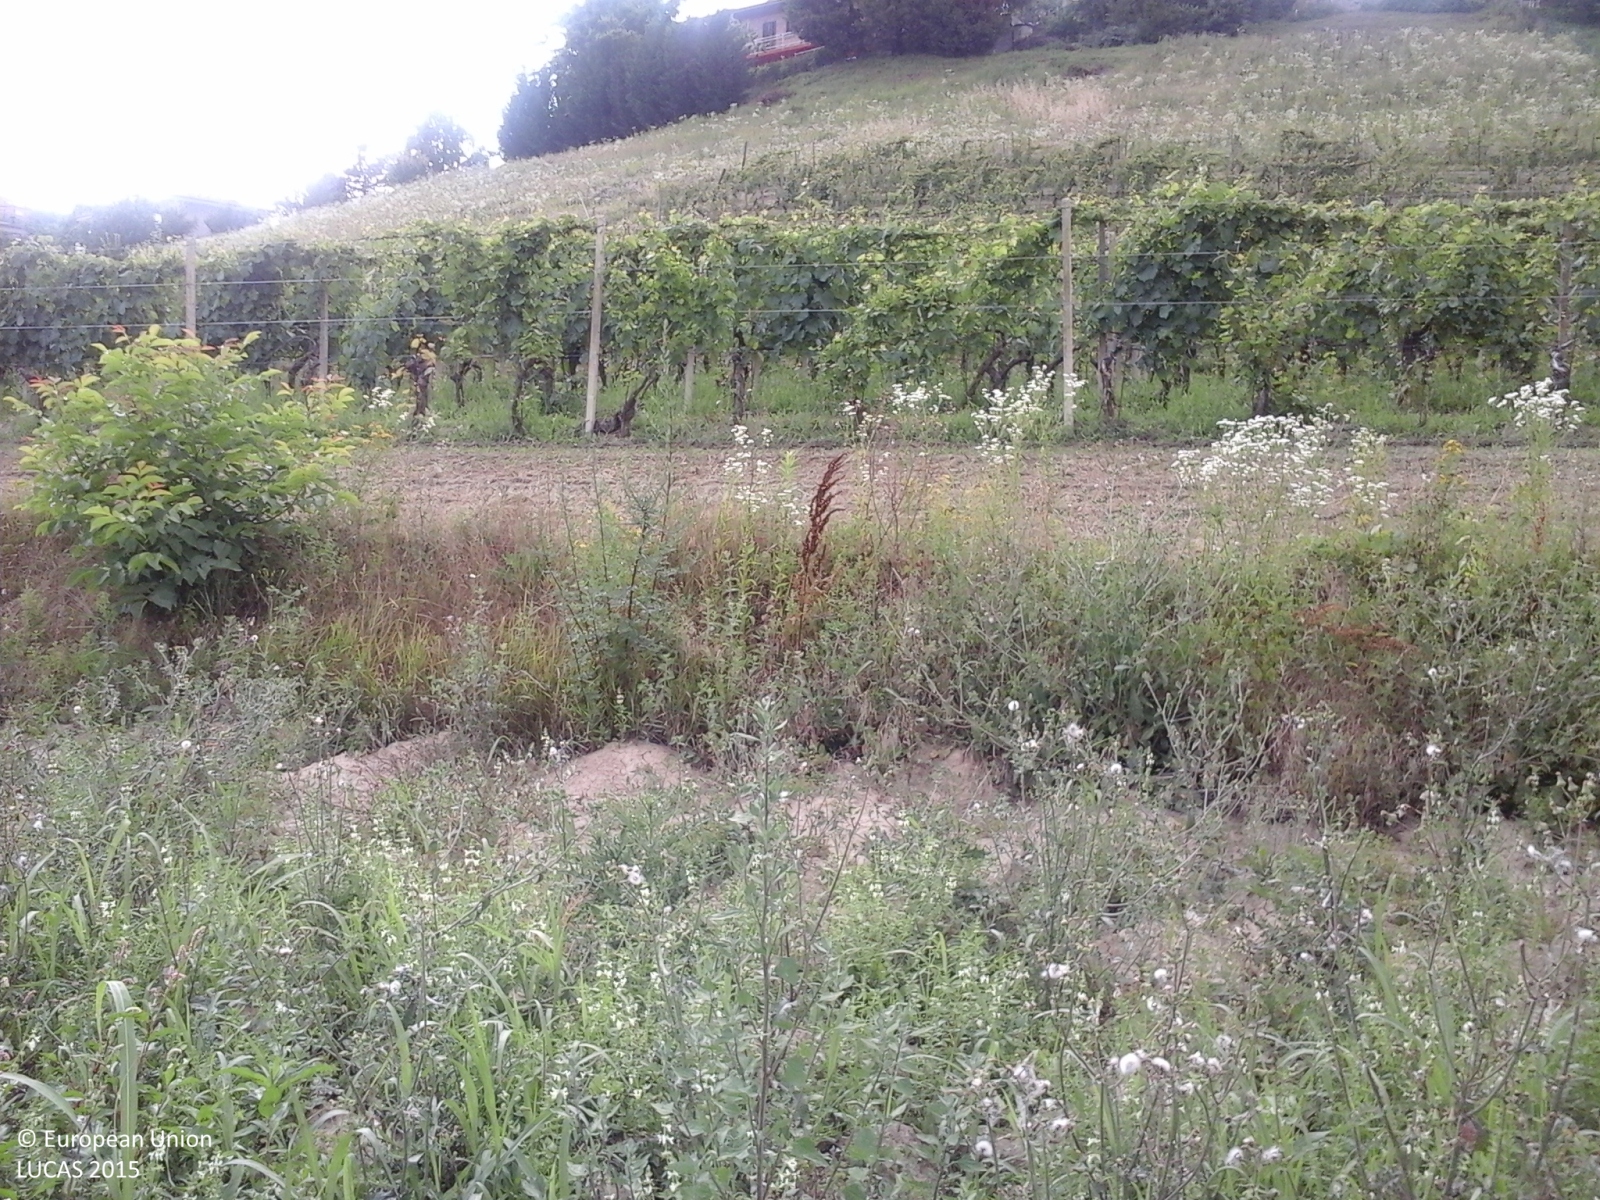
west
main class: Grassland
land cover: Spontaneously vegetated surfaces
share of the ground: > 75 %
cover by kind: herbaceous plants 90 %, consolidated bare surface 10 %
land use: Fallow land
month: June
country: IT
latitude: 44.7304
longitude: 8.1224
